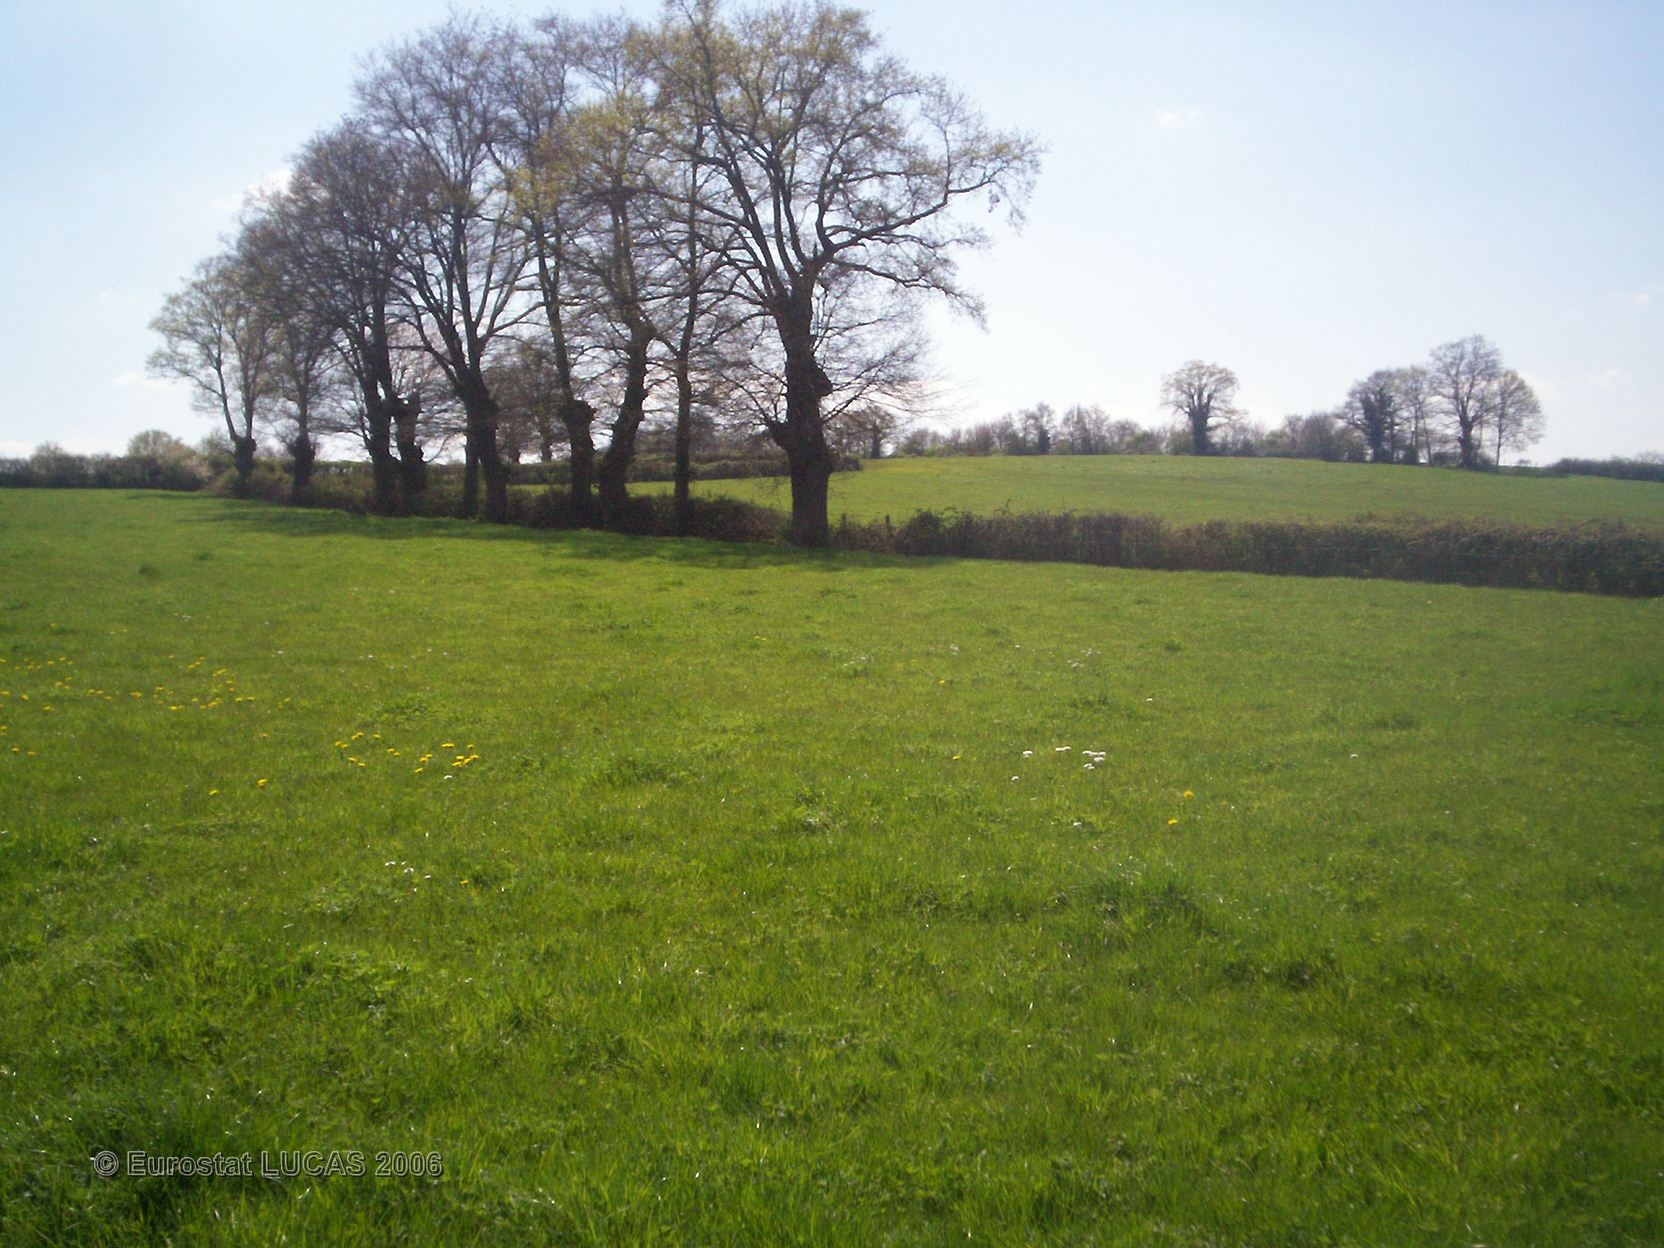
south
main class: Grassland
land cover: Grassland without tree/shrub cover
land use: Agriculture (excluding fallow land and kitchen gardens)
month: April
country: FR
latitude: 46.6514
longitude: 3.0848
